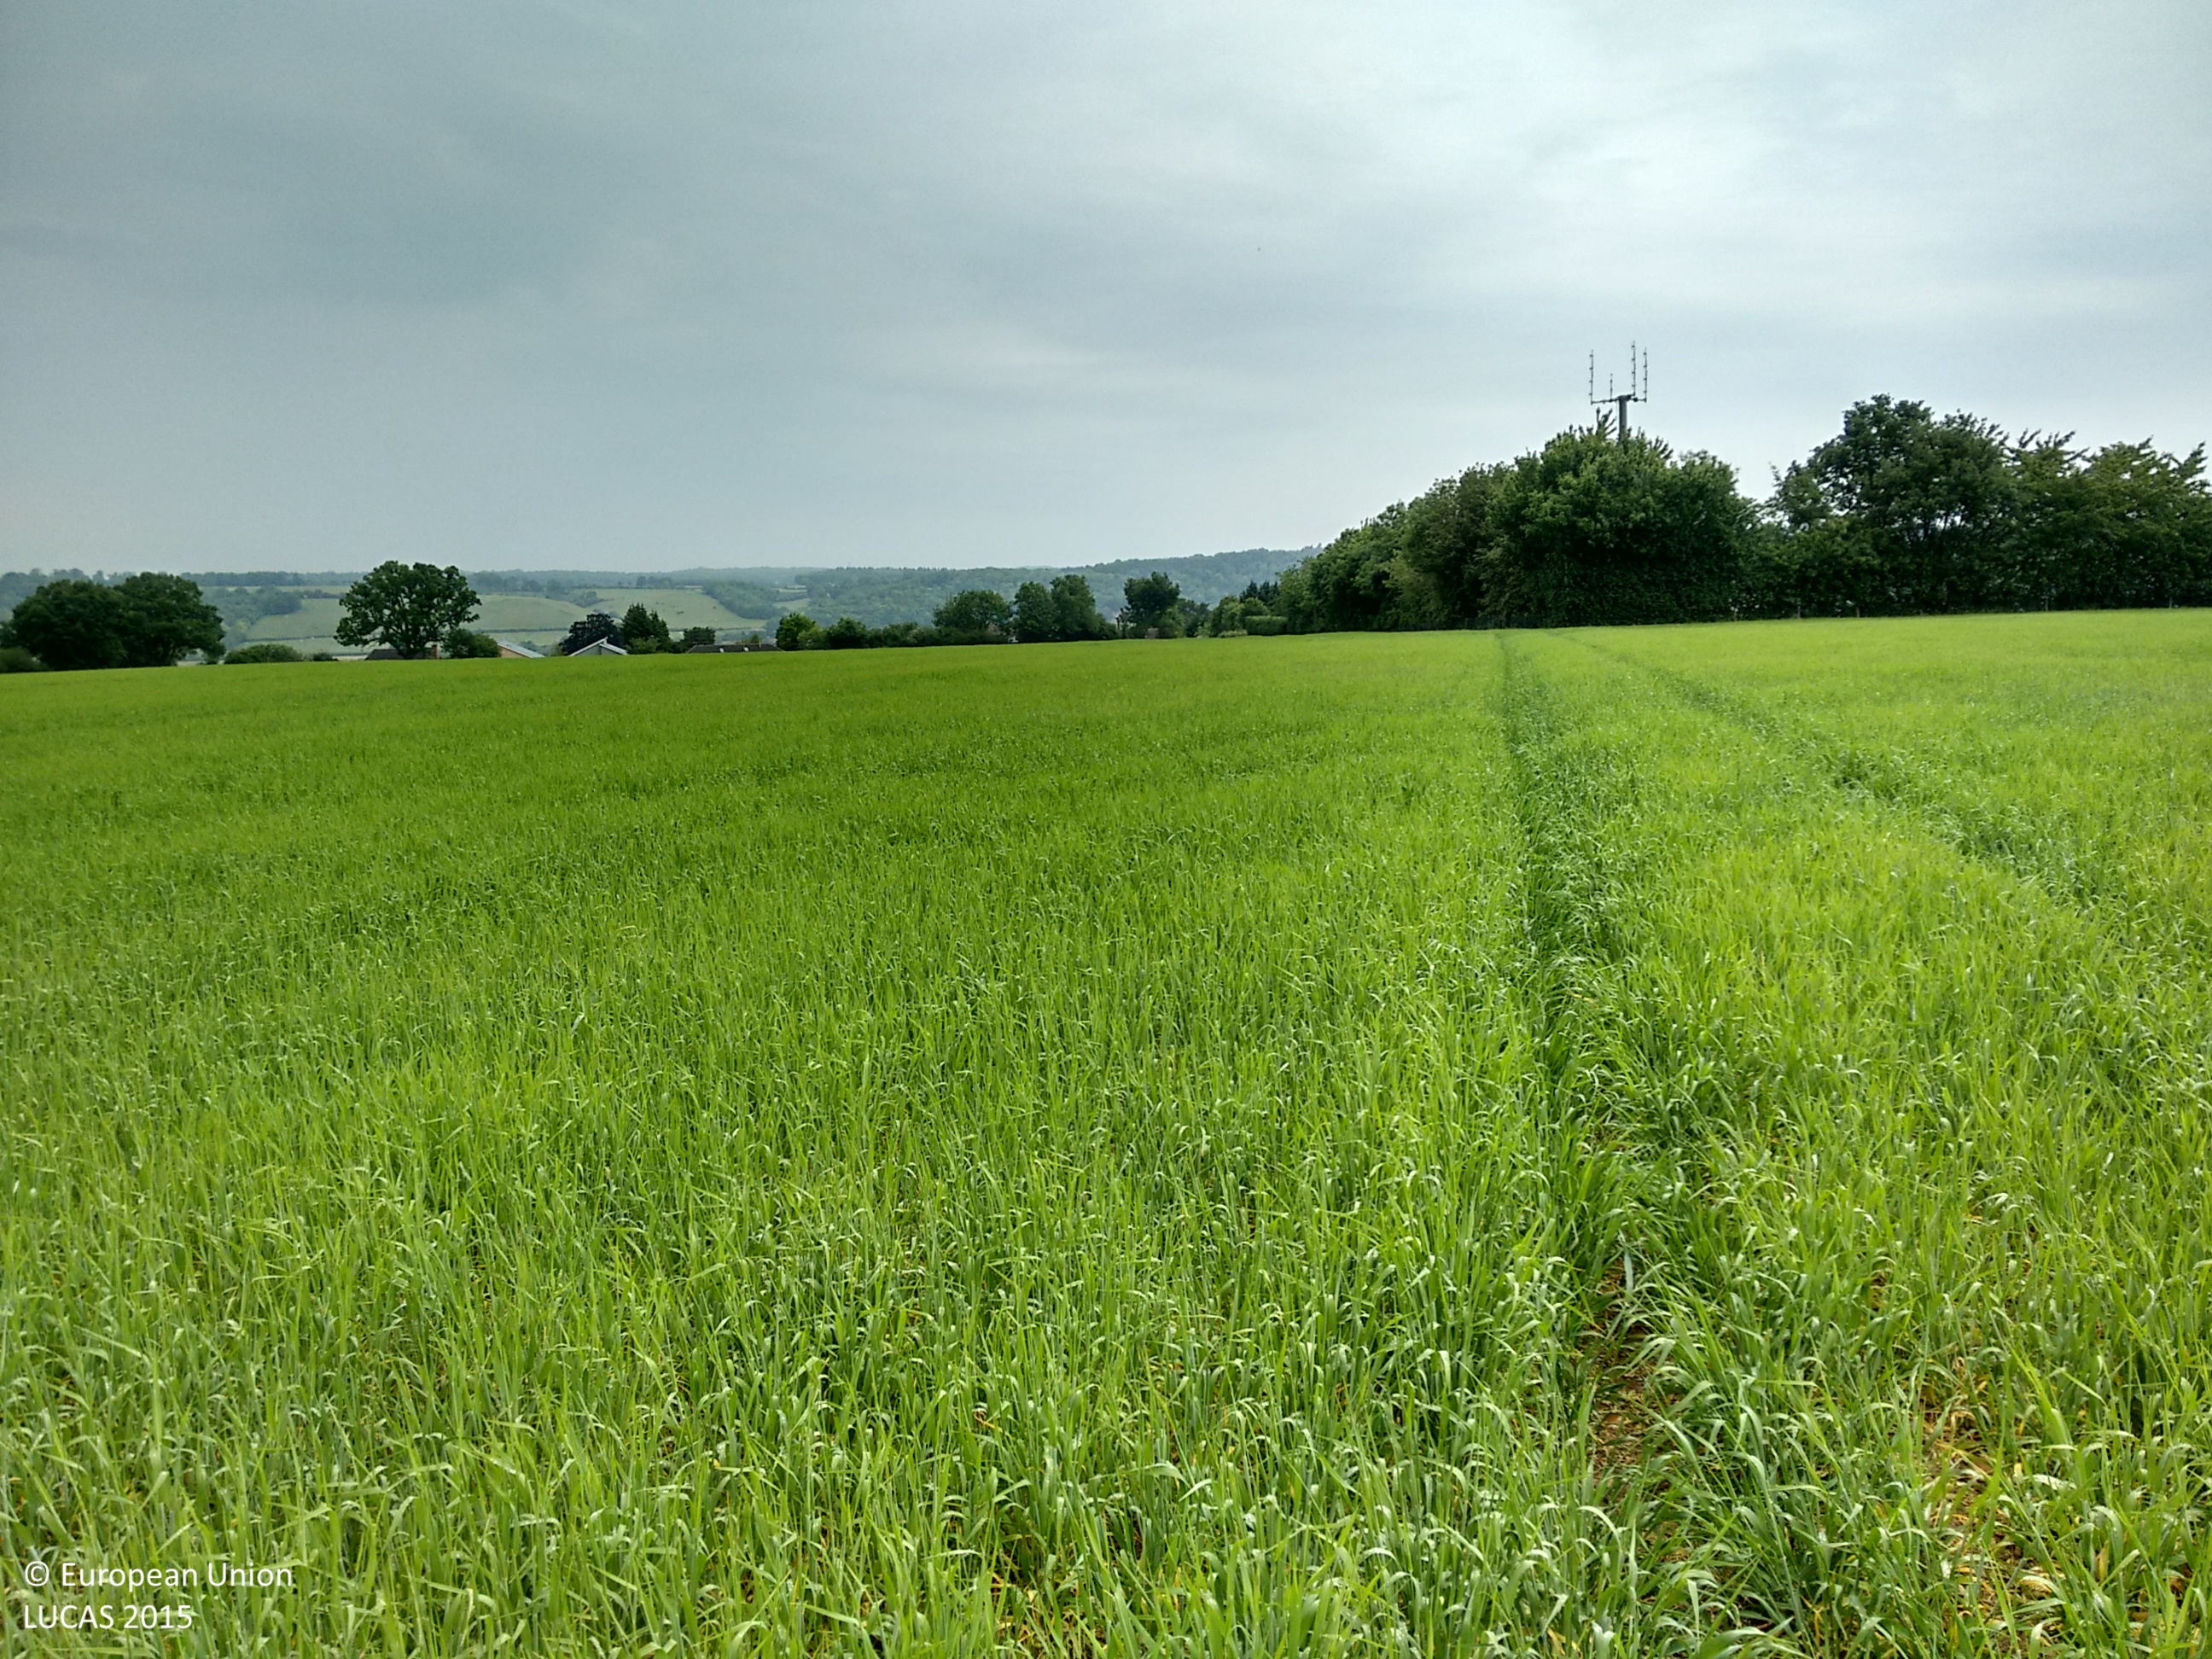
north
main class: Cropland
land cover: Barley
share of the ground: > 75 %
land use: Agriculture (excluding fallow land and kitchen gardens)
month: June
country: GB
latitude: 51.4777
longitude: -1.0601
